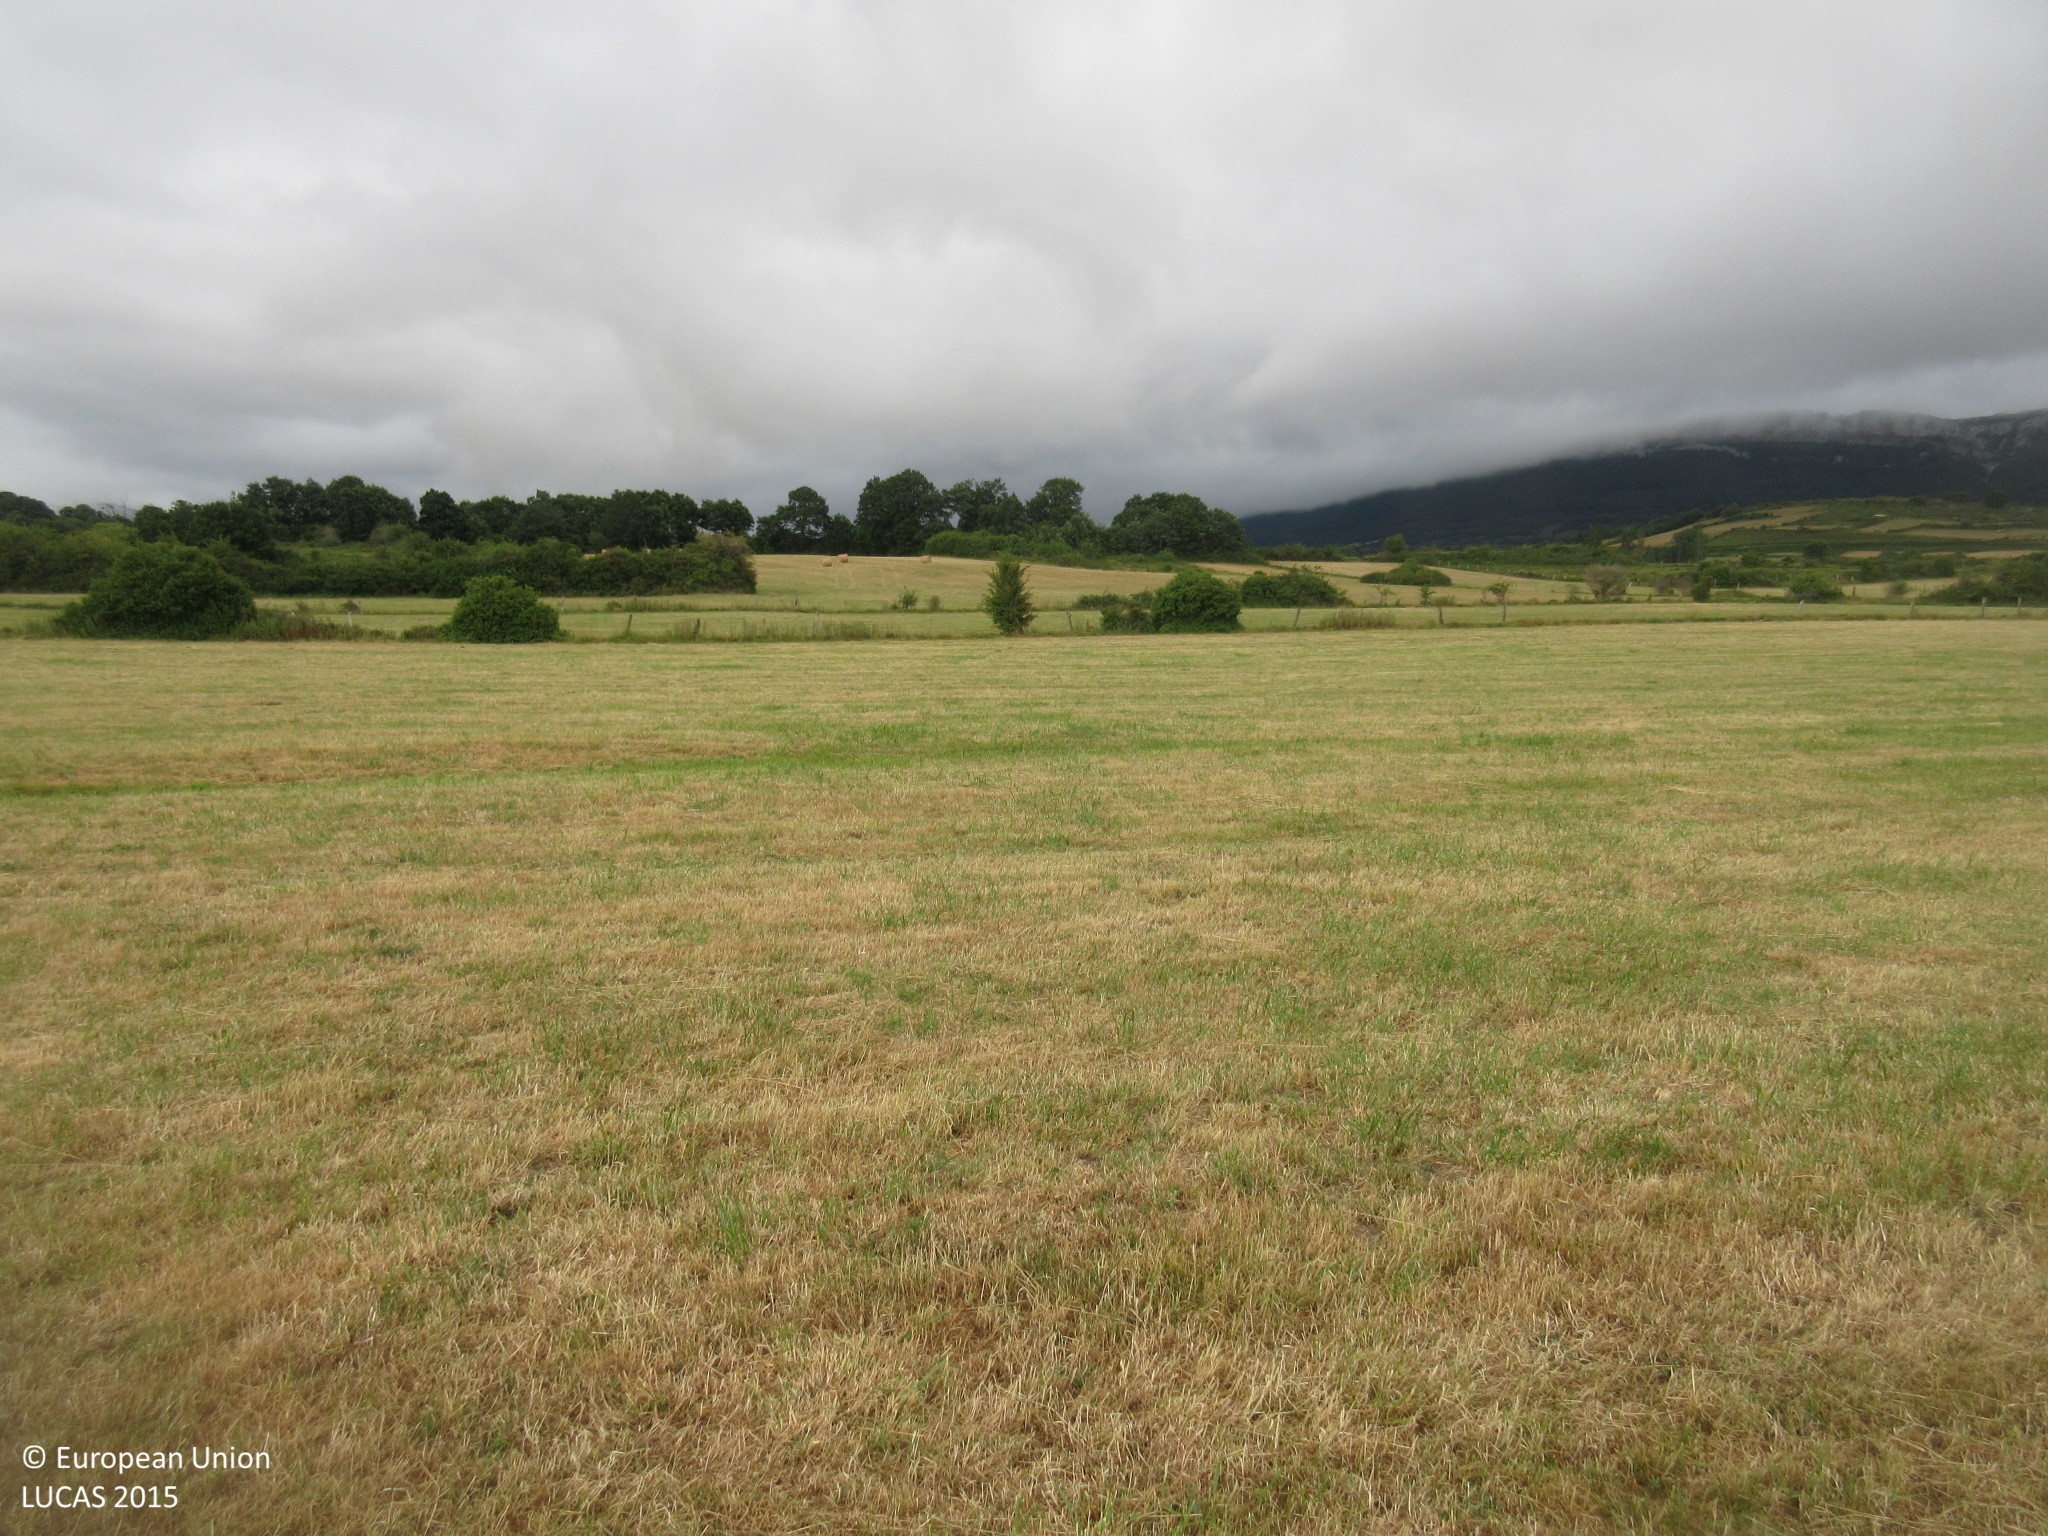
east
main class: Grassland
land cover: Grassland without tree/shrub cover
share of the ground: > 75 %
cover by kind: herbaceous plants 100 %
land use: Agriculture (excluding fallow land and kitchen gardens)
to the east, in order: Grassland without tree/shrub cover; Grass margins; Grassland without tree/shrub cover; Abandoned hedges; Grassland without tree/shrub cover
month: July
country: ES
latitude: 43.0813
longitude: -3.4903
